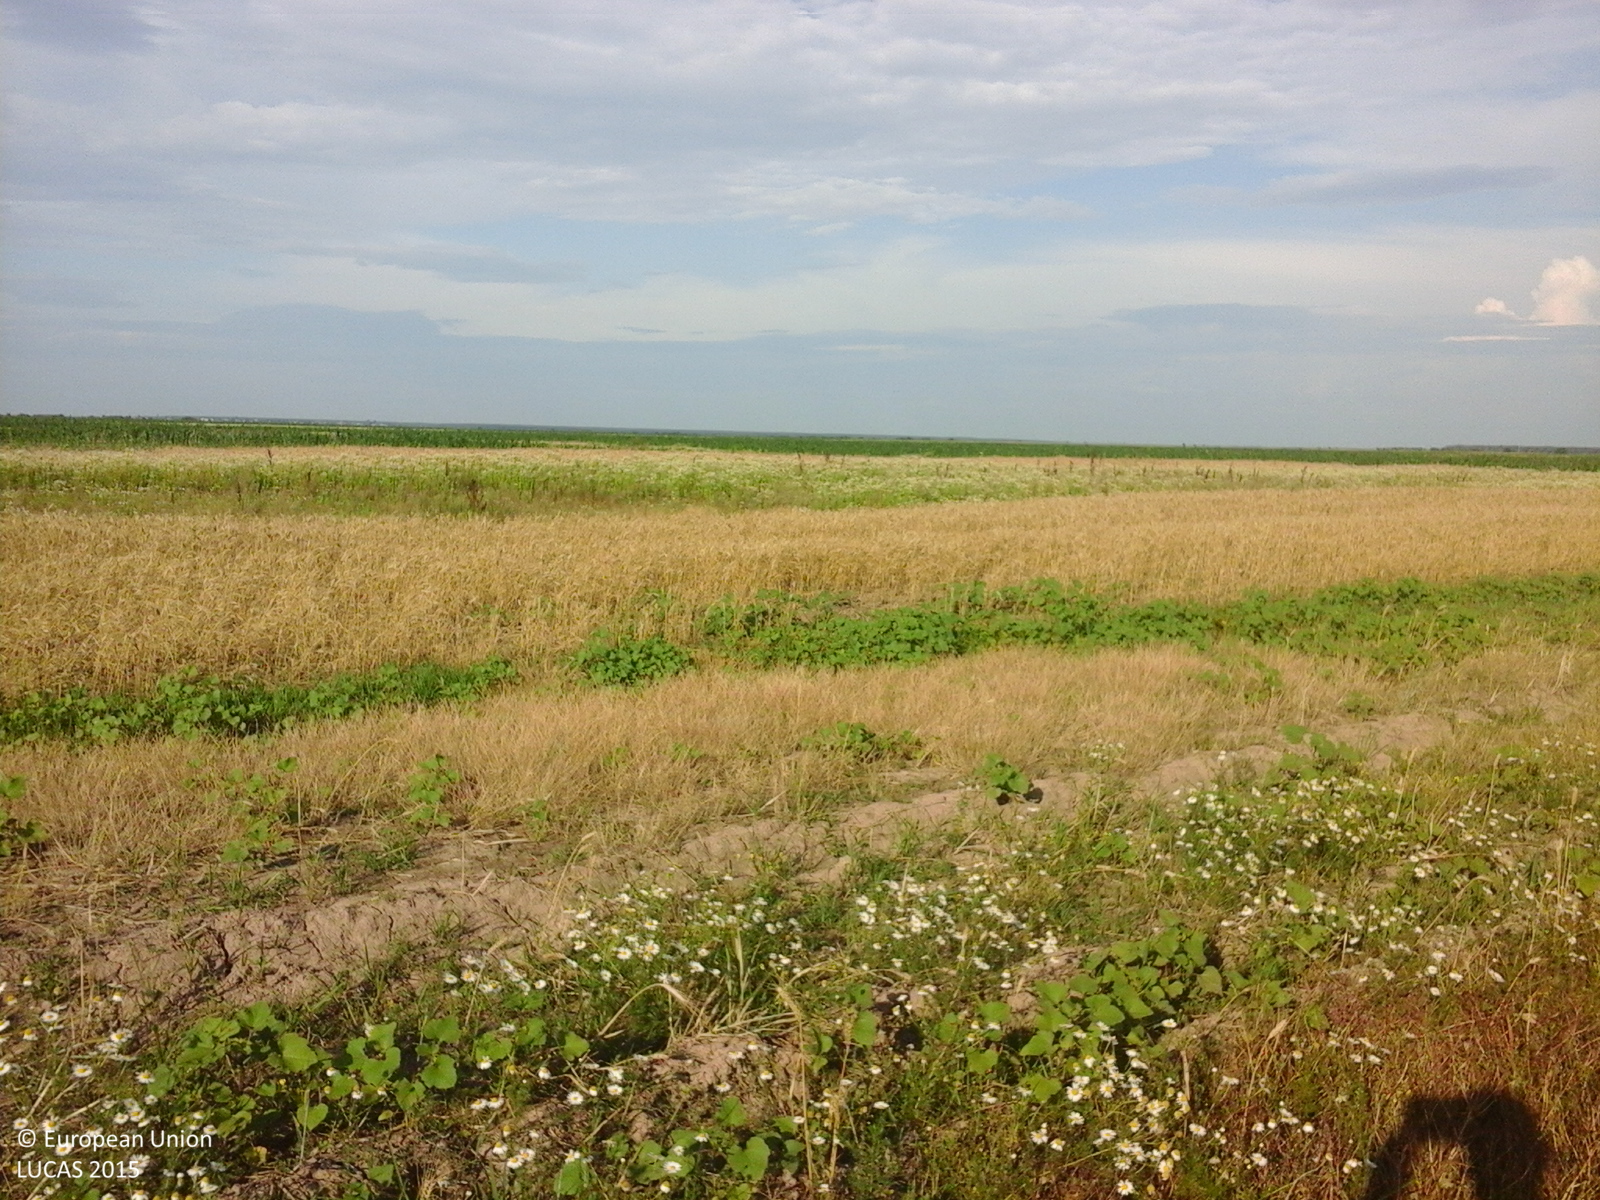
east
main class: Grassland
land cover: Spontaneously vegetated surfaces
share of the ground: < 10 %
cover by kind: herbaceous plants 100 %
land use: Fallow land
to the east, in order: Spontaneously vegetated surfaces; Common wheat; Tracks; Maize; Common wheat
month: July
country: RO
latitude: 44.4138
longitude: 25.4489
